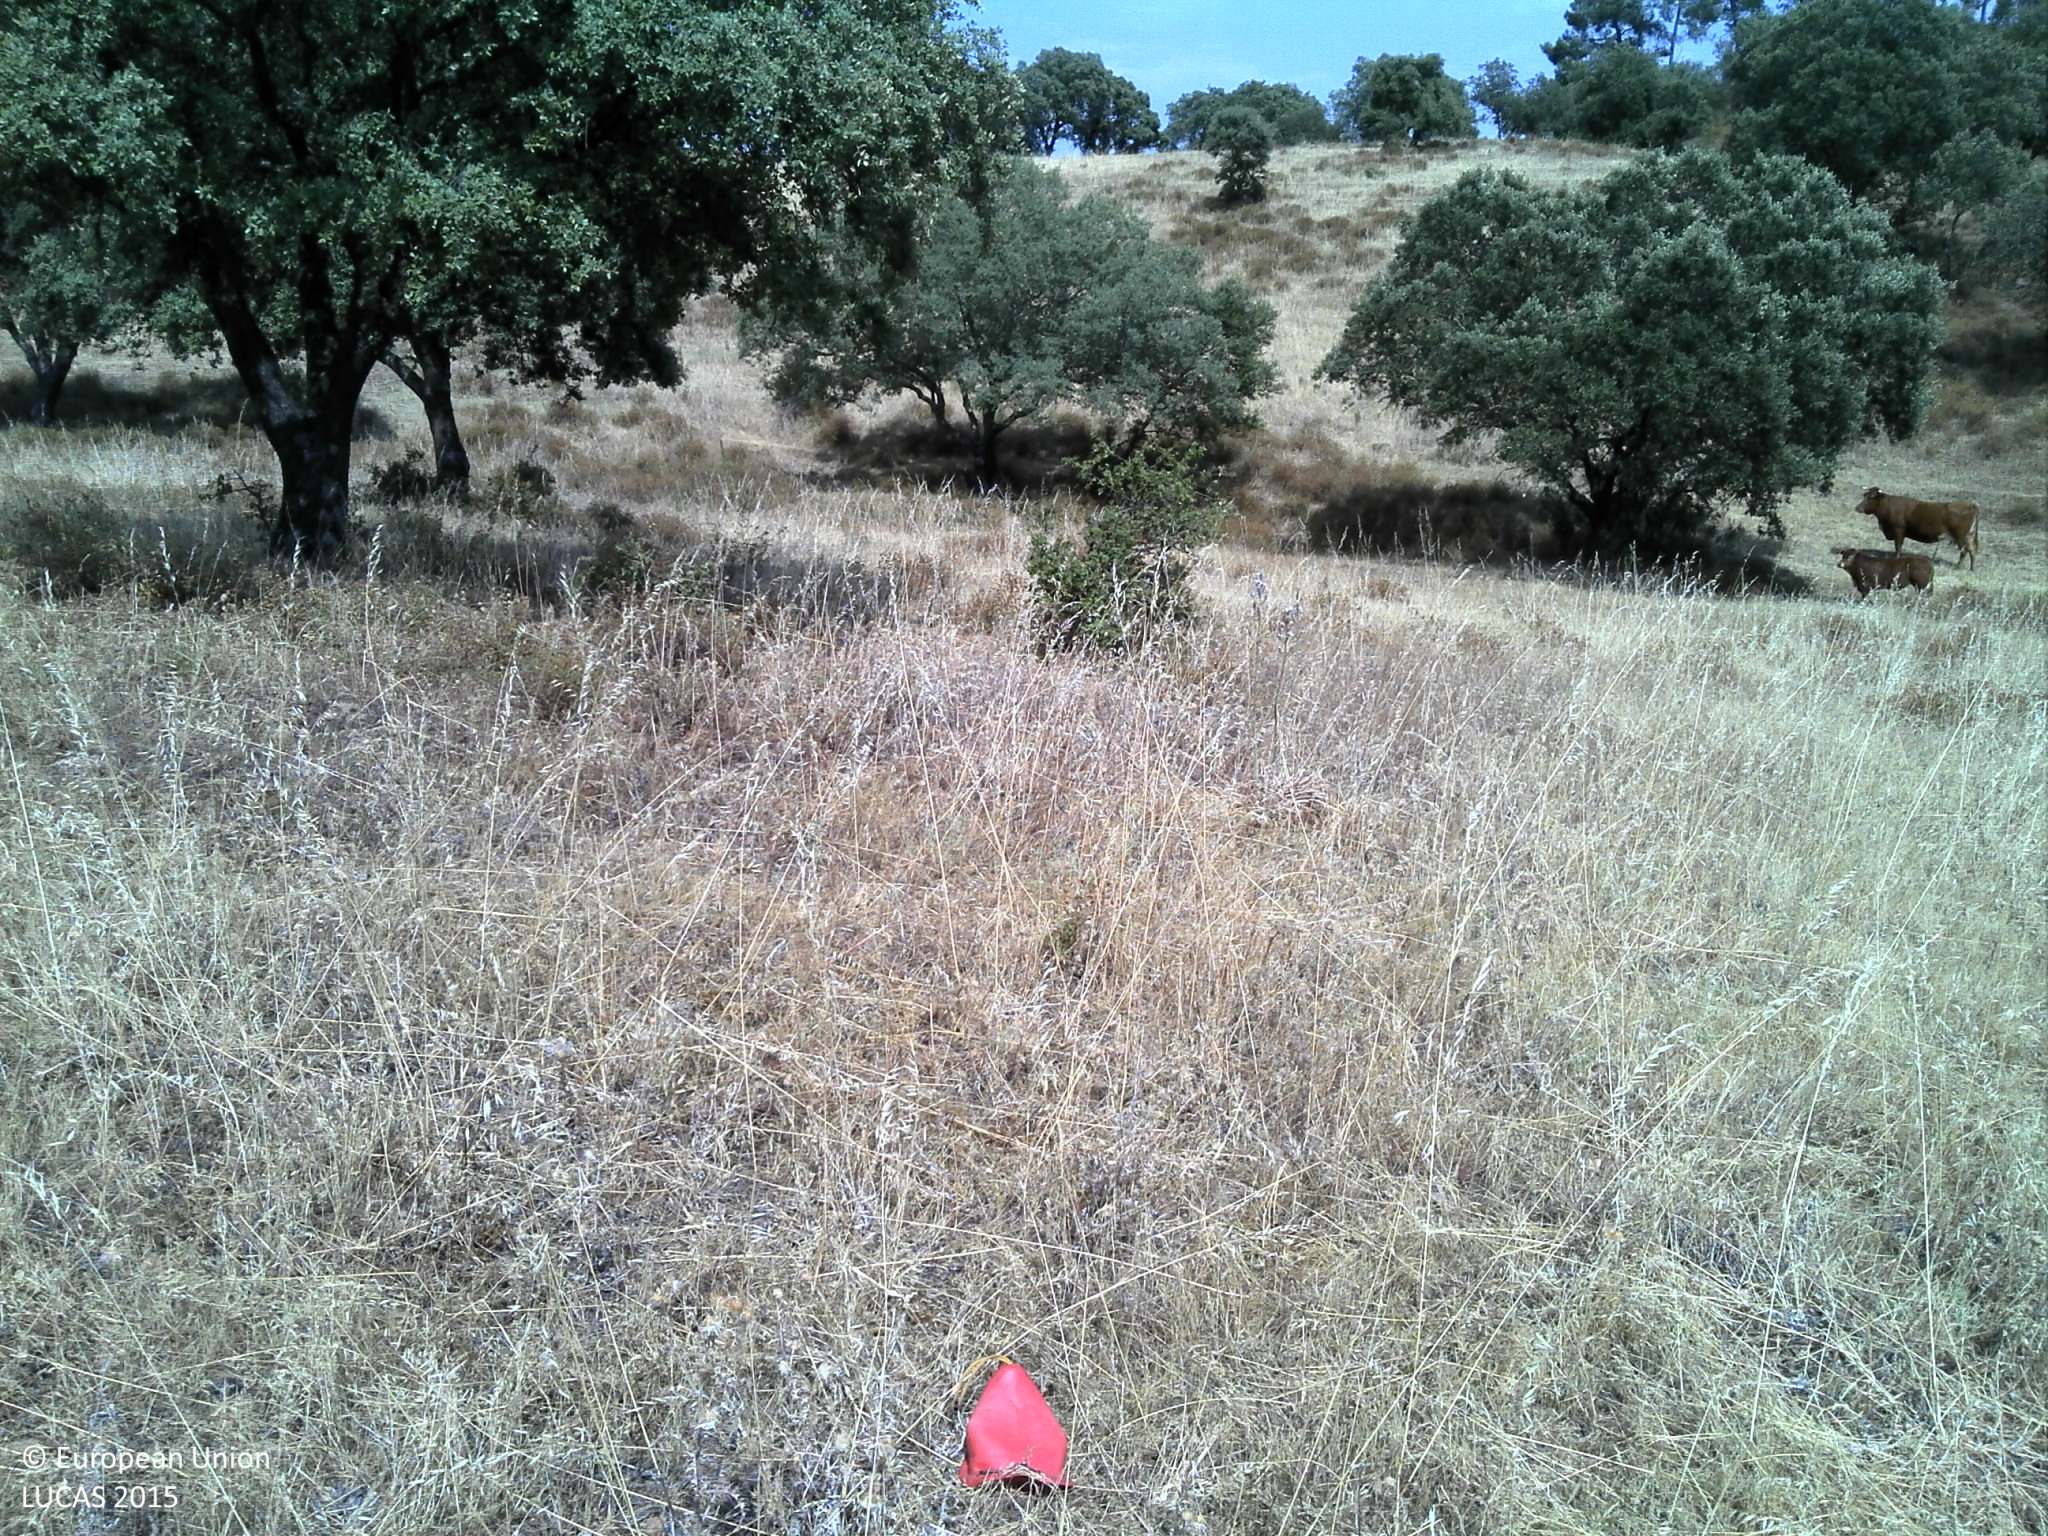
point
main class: Grassland
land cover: Grassland with sparse tree/shrub cover
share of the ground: > 75 %
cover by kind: herbaceous plants 80 %, unconsolidated bare surface 15 %, broadleaved forest trees 5 %
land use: Agriculture (excluding fallow land and kitchen gardens)
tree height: > 5 m
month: June
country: PT
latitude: 38.6620
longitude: -7.6997
